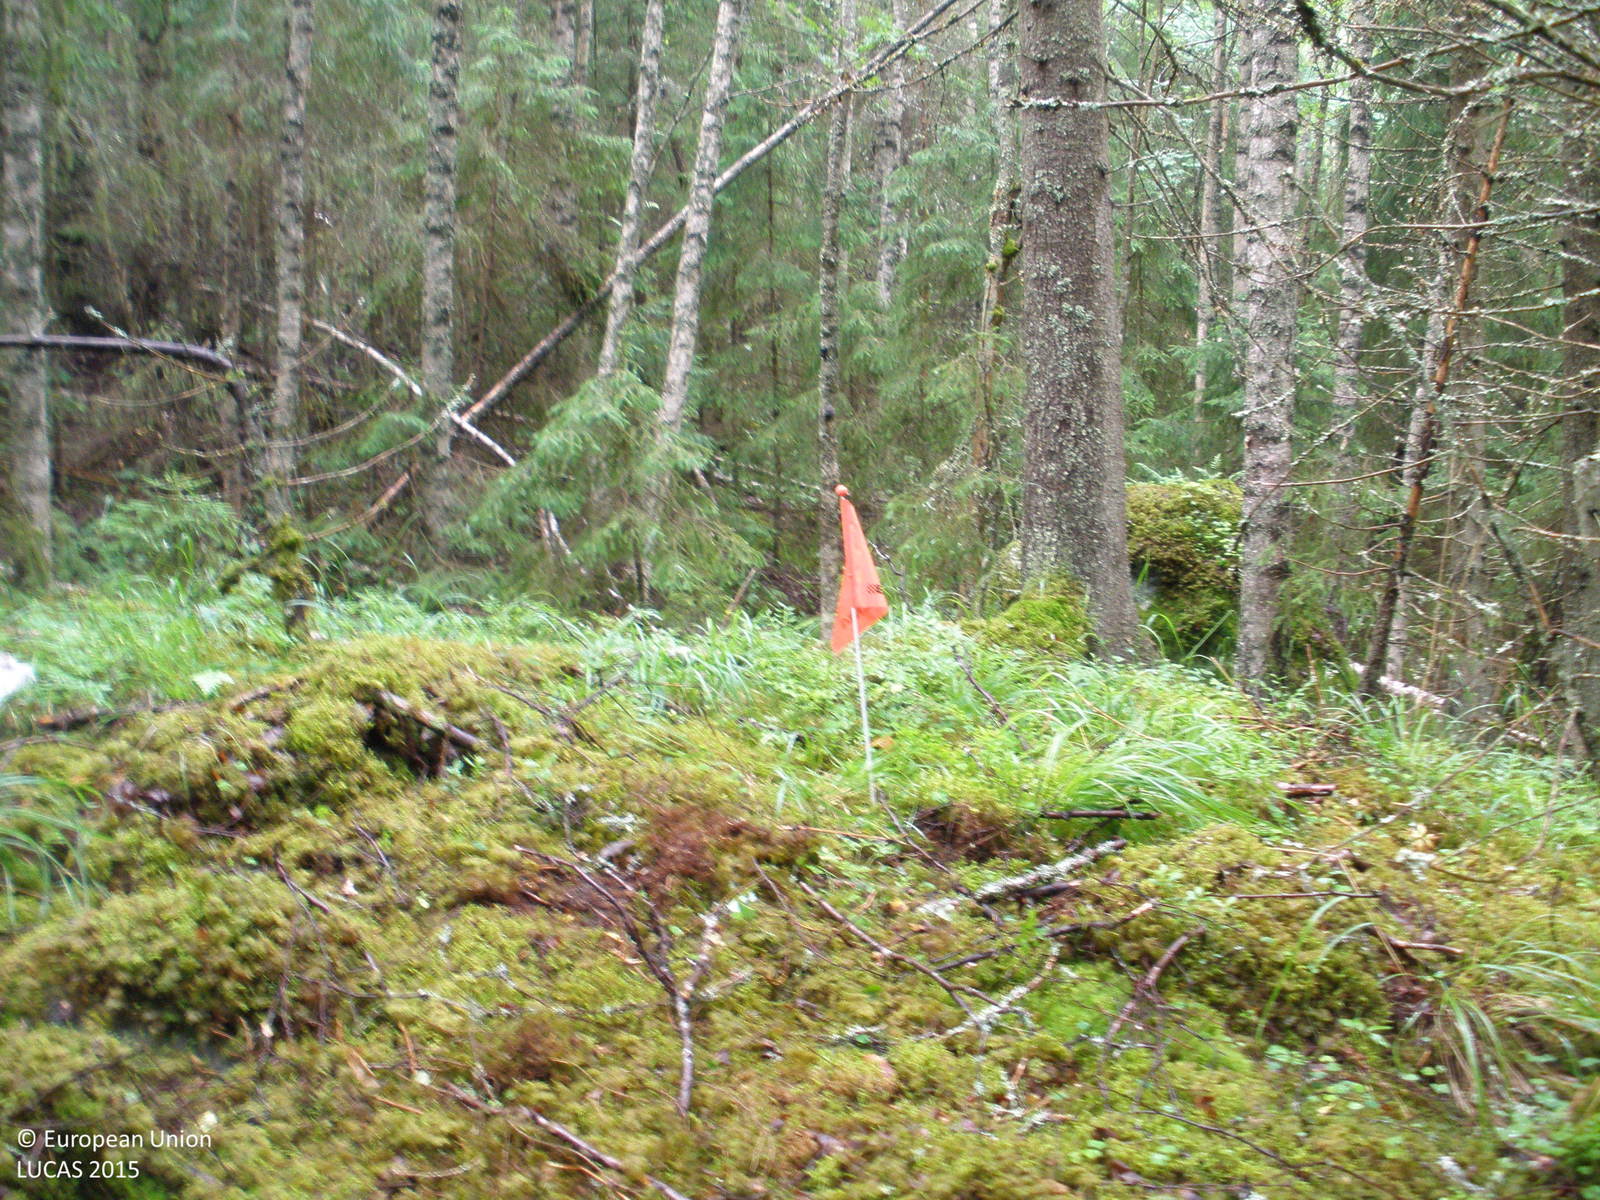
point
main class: Woodland
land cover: Spruce dominated mixed woodland
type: boreal forest
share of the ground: > 75 %
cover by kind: coniferous forest trees 40 %, broadleaved forest trees 40 %, herbaceous plants 10 %, lichens and mosses 10 %
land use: Forestry
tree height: > 5 m
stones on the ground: 10 - 25 %
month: July
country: FI
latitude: 61.4509
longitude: 23.3001
